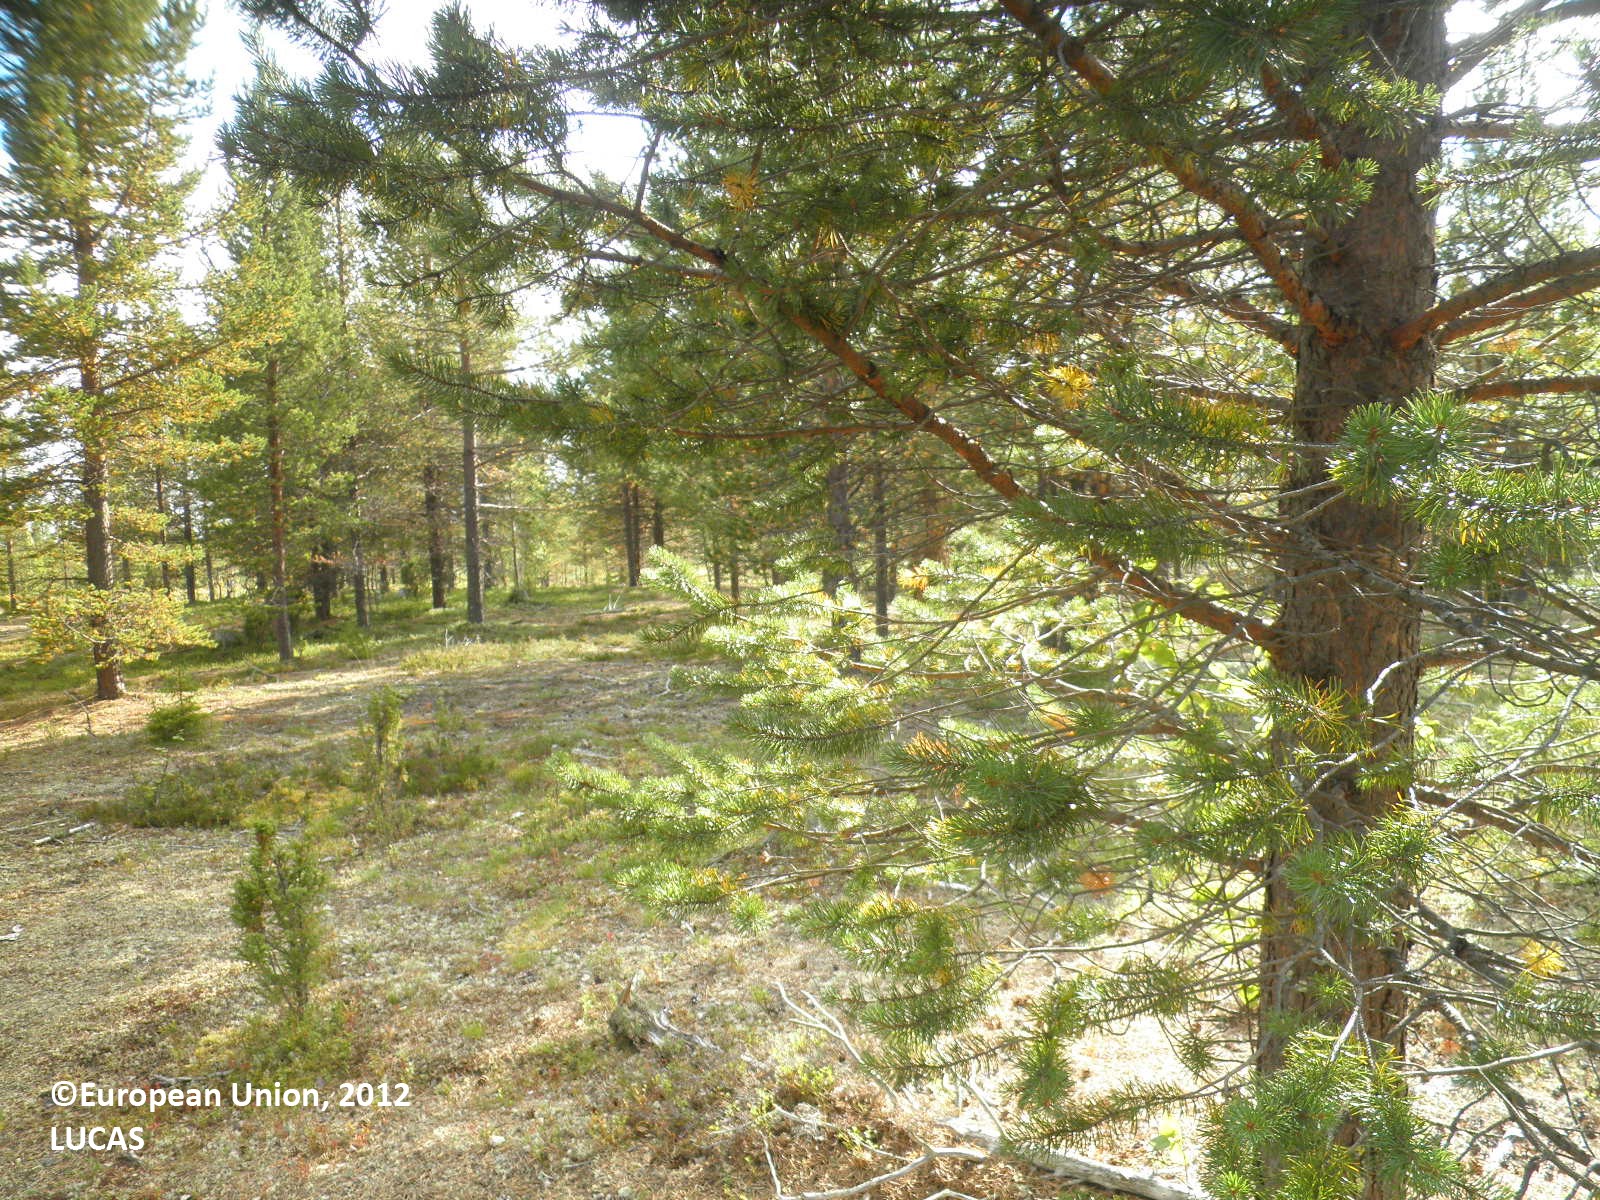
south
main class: Woodland
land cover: Pine dominated coniferous woodland
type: boreal forest
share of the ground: 25 - 50 %
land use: Forestry
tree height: > 5 m
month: August
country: FI
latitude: 67.5951
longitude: 29.9031
